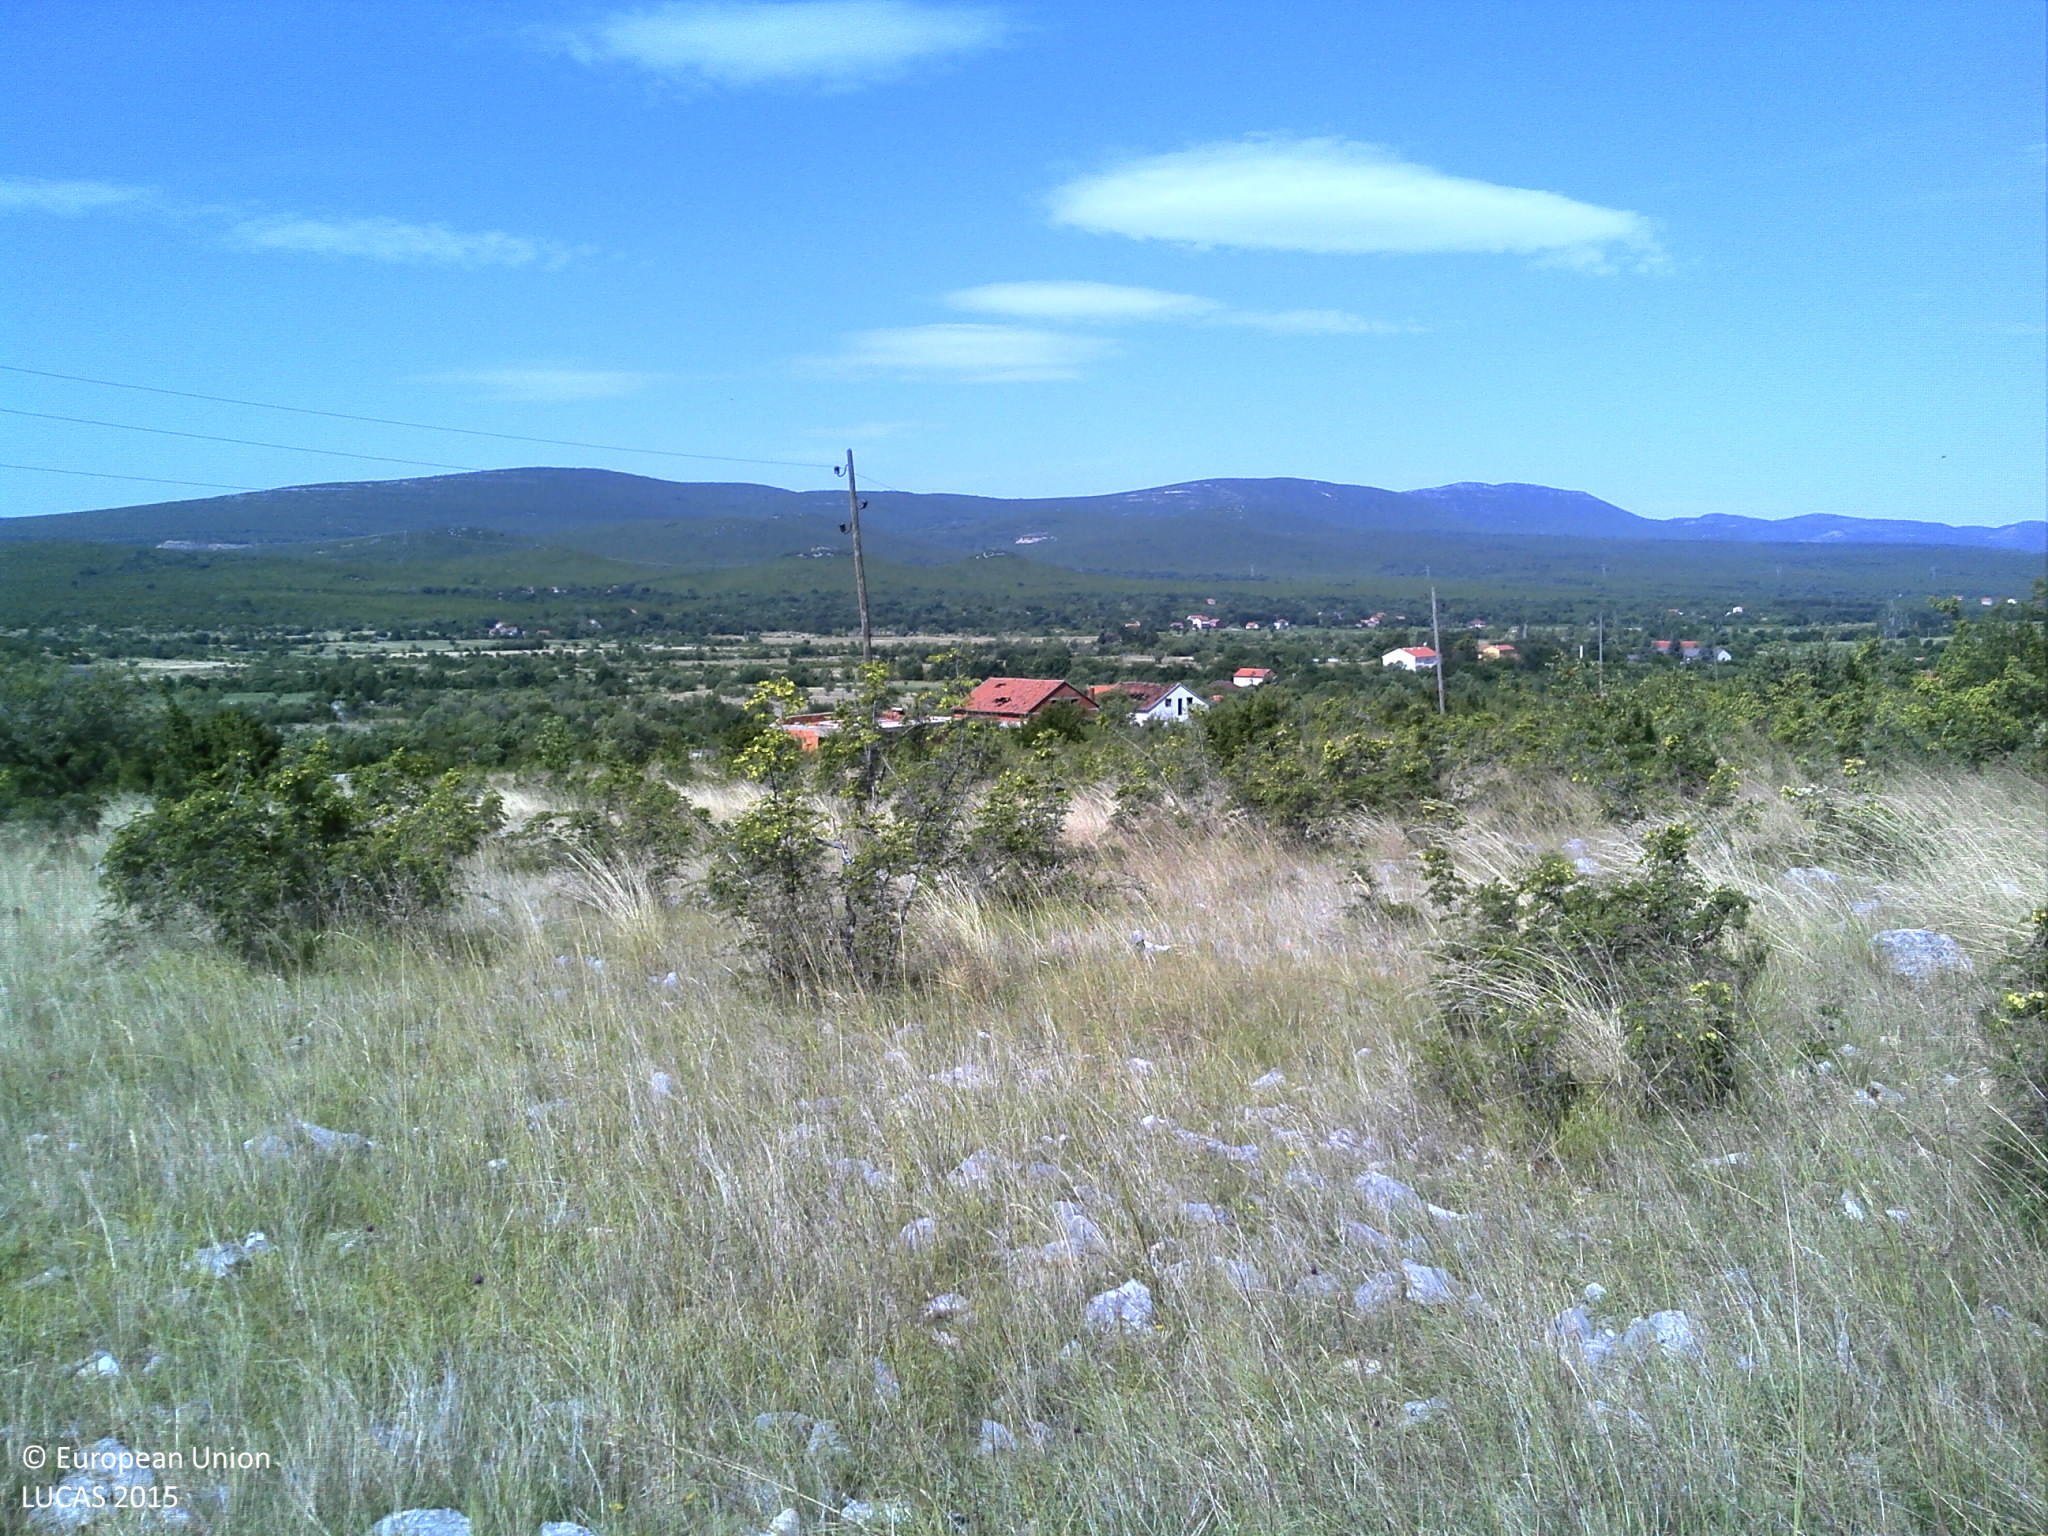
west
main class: Shrubland
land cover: Shrubland with sparse tree cover
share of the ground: 25 - 50 %
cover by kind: herbaceous plants 50 %, shrubs 40 %, broadleaved forest trees 5 %, unconsolidated bare surface 5 %
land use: Semi-natural and natural areas not in use
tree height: < 5 m
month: June
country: HR
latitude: 44.1074
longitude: 15.9518
